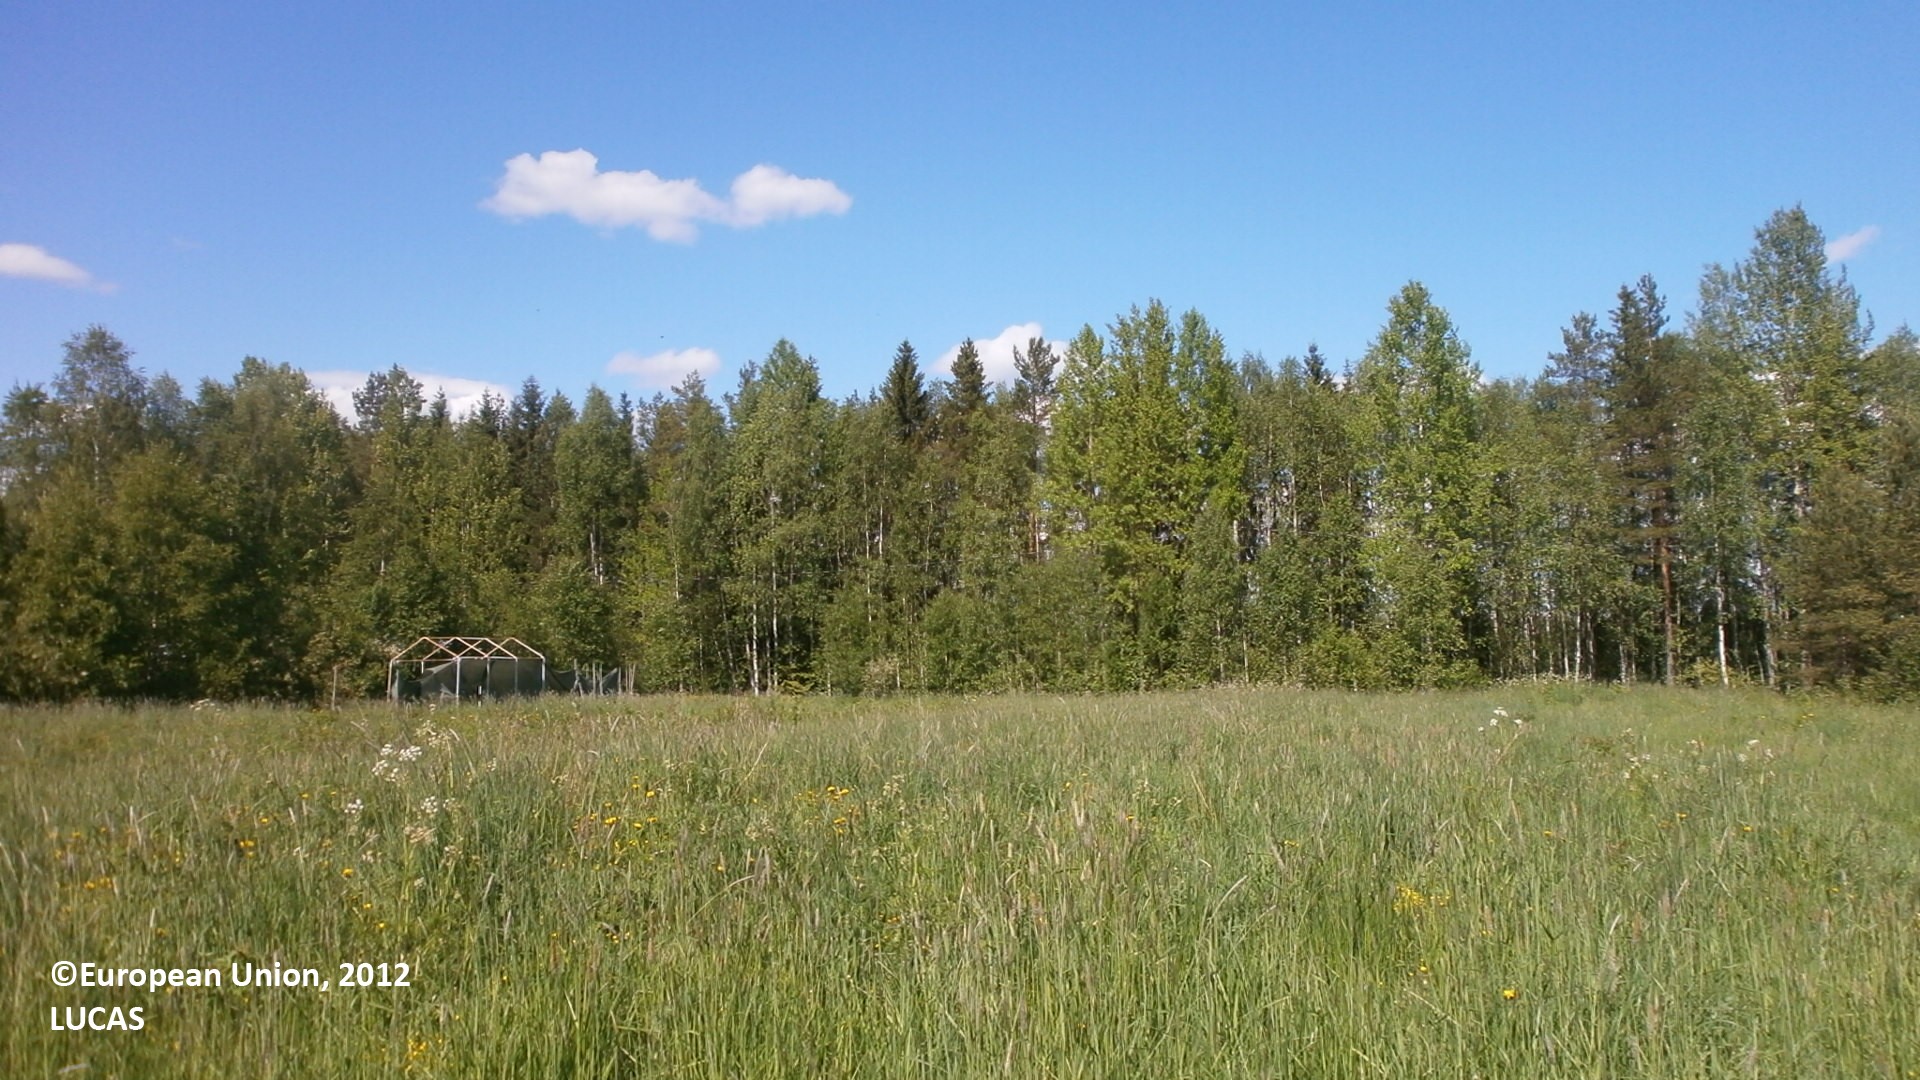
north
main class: Grassland
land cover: Grassland without tree/shrub cover
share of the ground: > 75 %
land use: Agriculture (excluding fallow land and kitchen gardens)
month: June
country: FI
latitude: 63.9803
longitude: 25.6897
